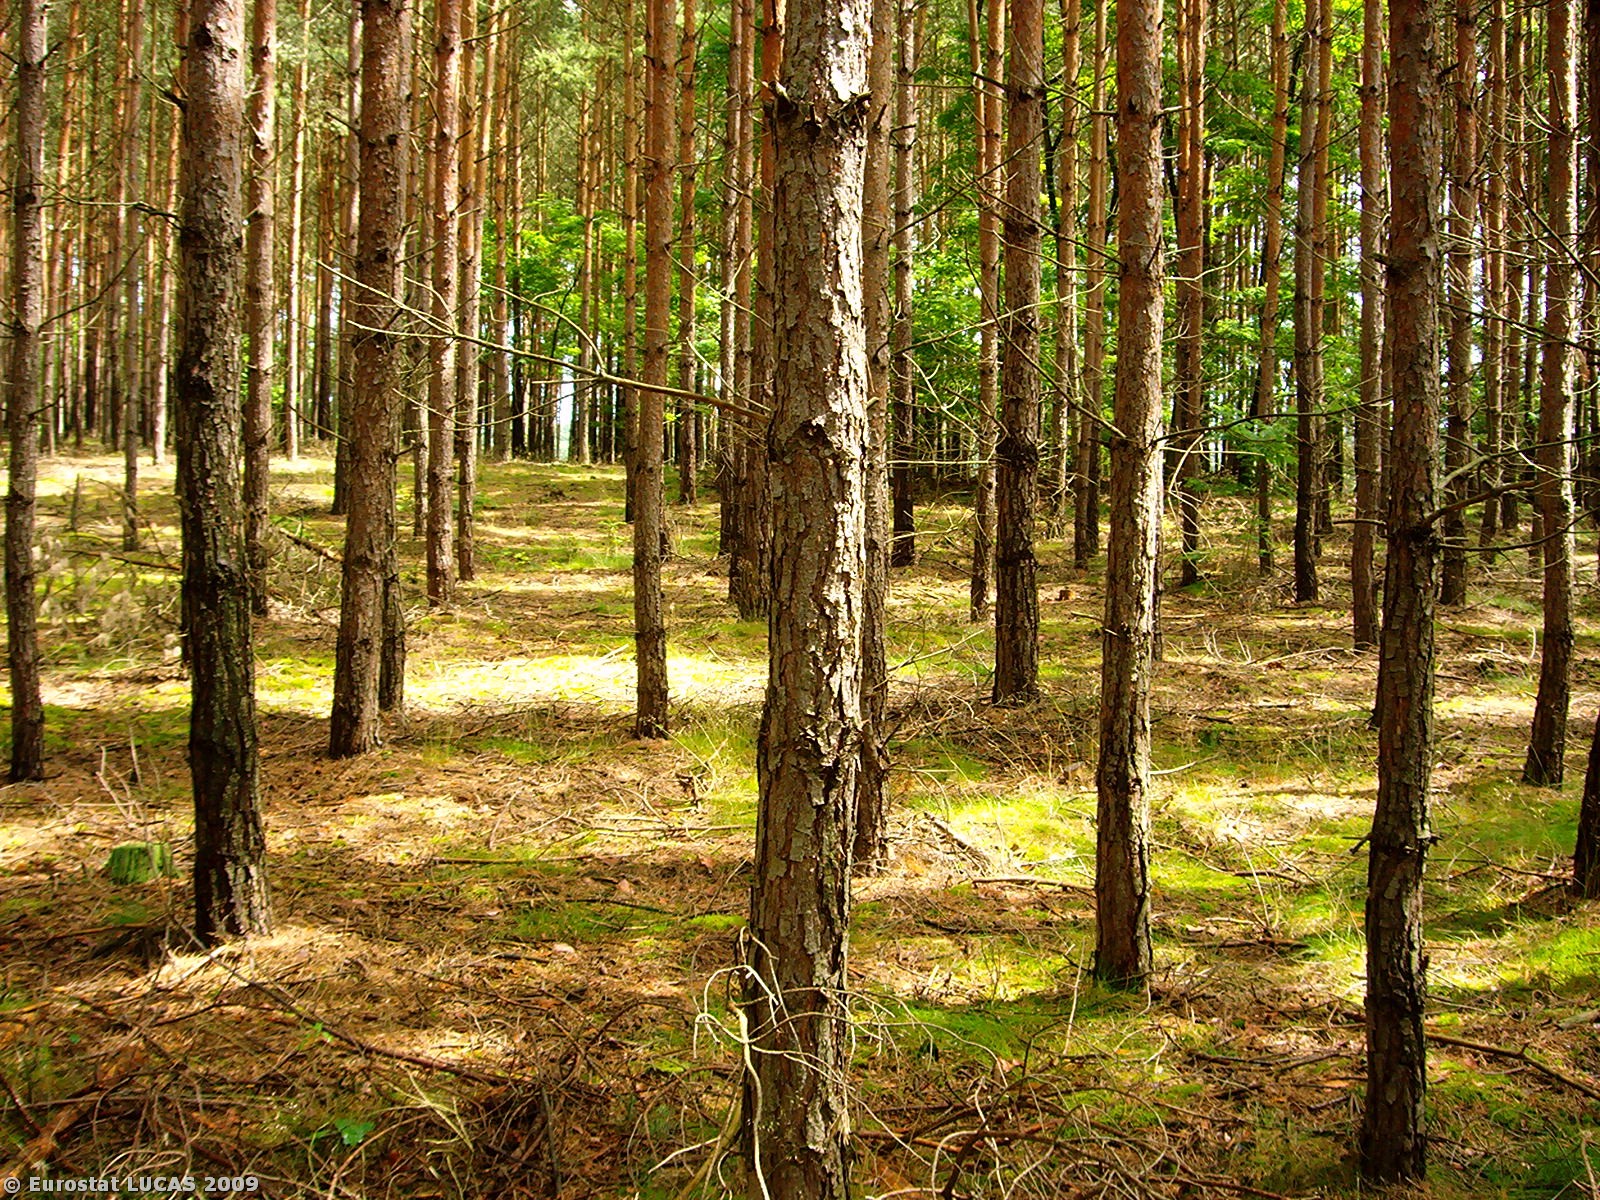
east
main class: Woodland
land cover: Coniferous woodland
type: hemiboreal forest and nemoral coniferous forest and mixed broadleaved-coniferous forest
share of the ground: > 75 %
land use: Forestry
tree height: > 5 m
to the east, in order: Coniferous woodland; Grass margins; Tracks; Grass margins; Triticale
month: July
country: PL
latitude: 52.2927
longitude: 15.3552
